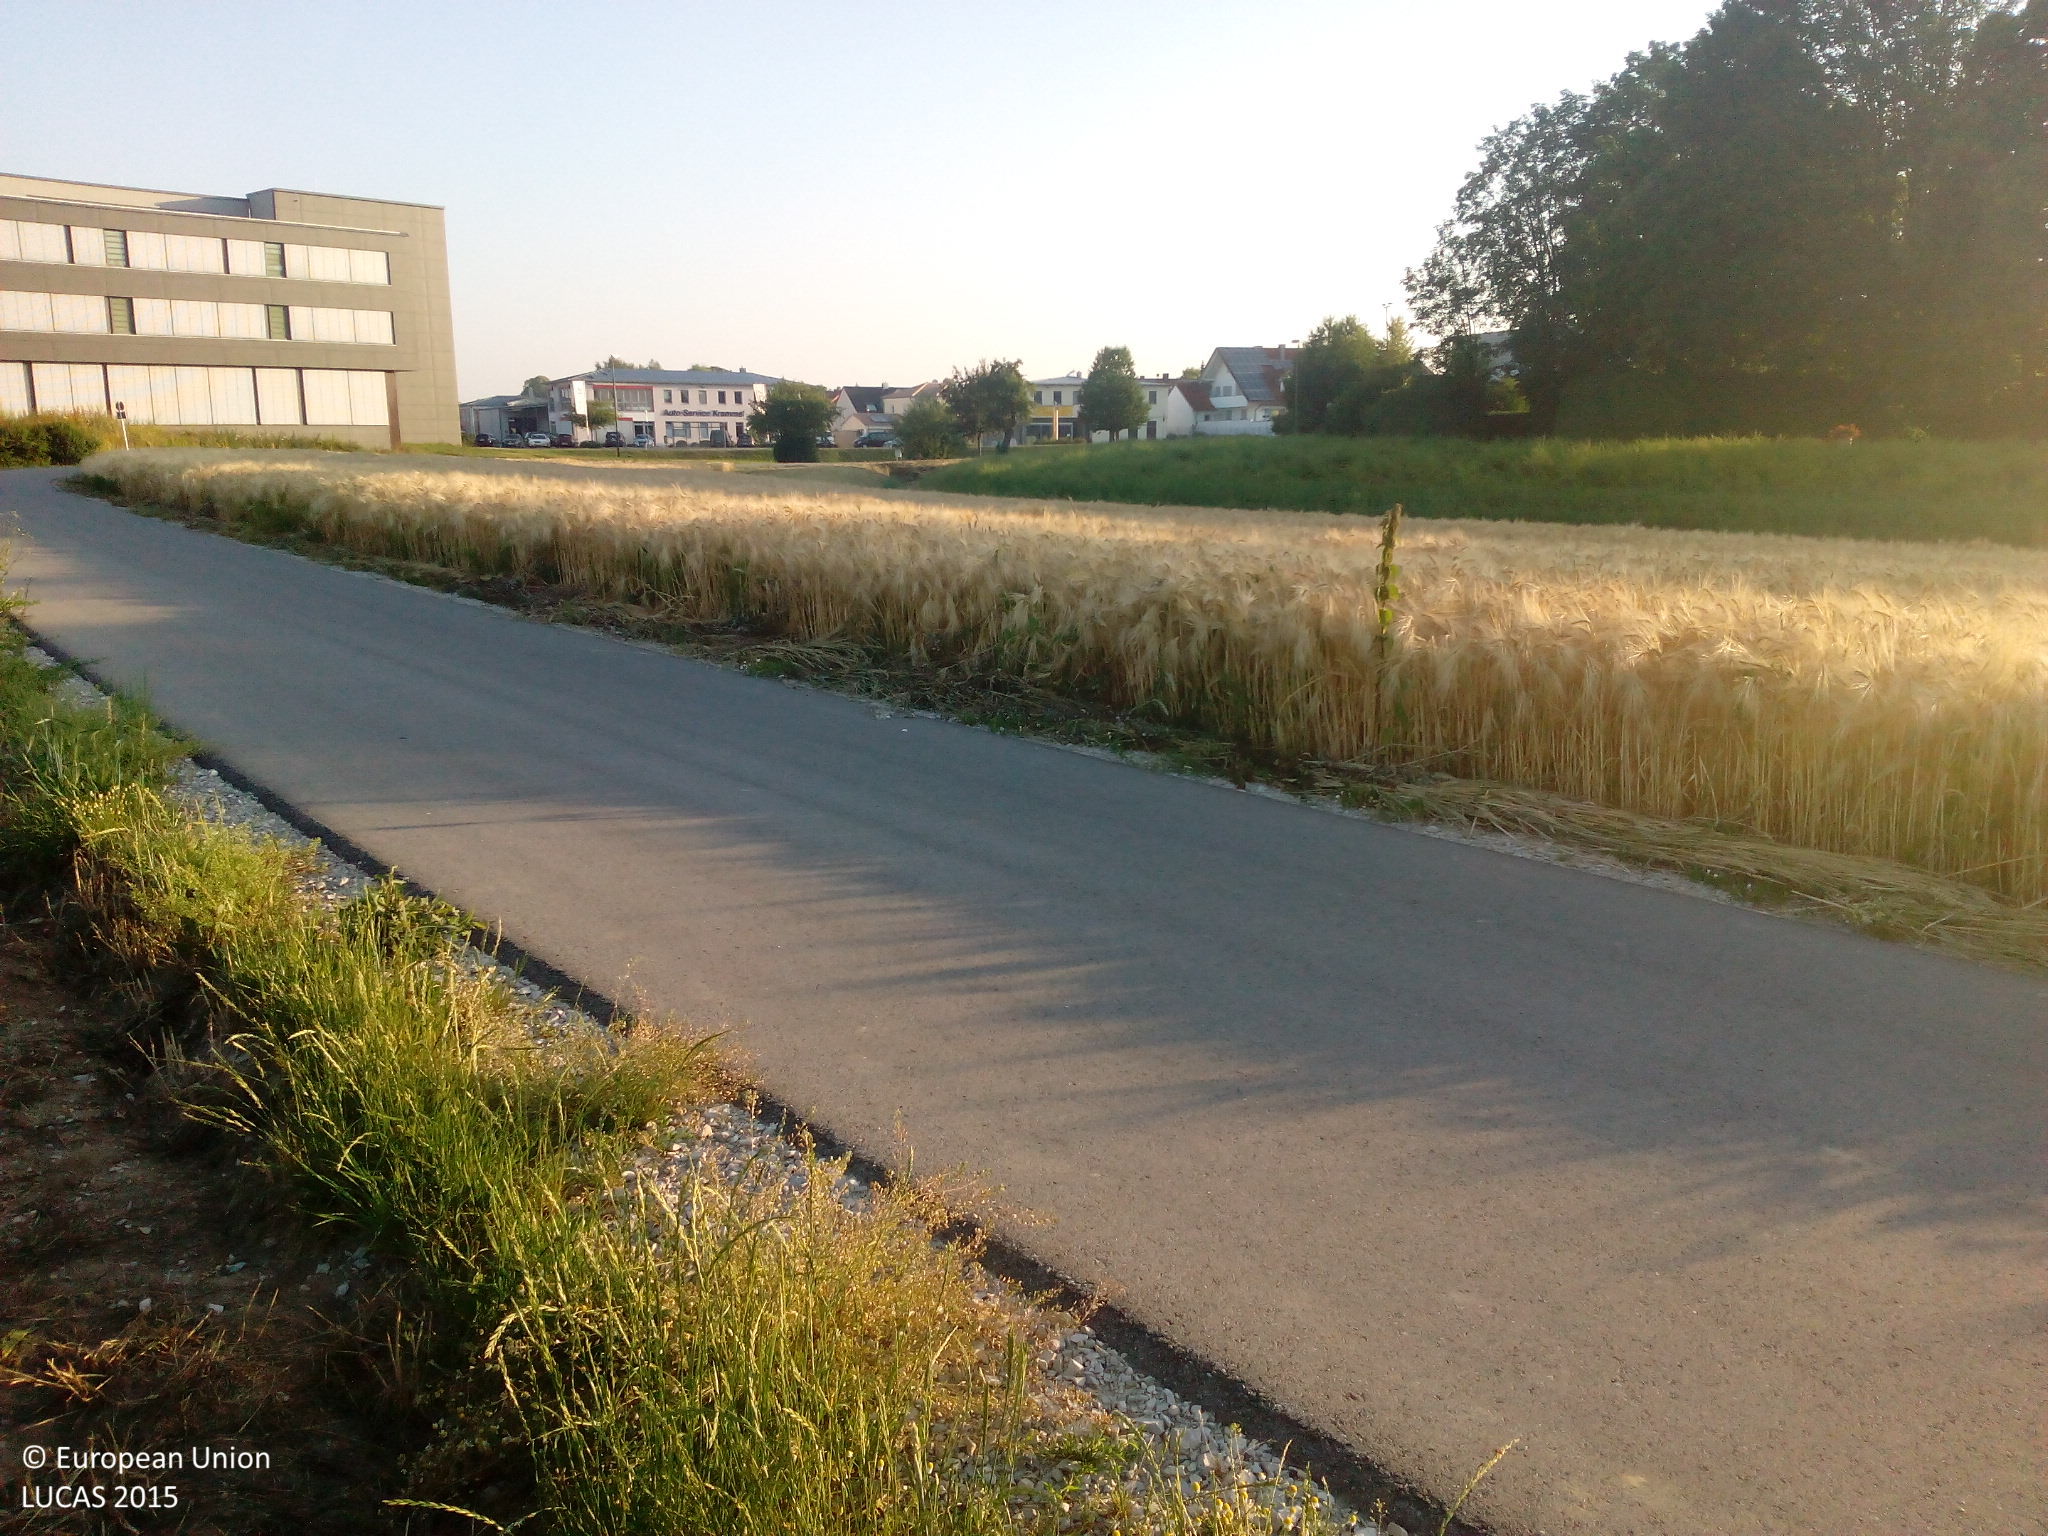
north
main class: Cropland
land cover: Sugar beet
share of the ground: > 75 %
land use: Agriculture (excluding fallow land and kitchen gardens)
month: July
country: DE
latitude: 48.8074
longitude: 11.4836
